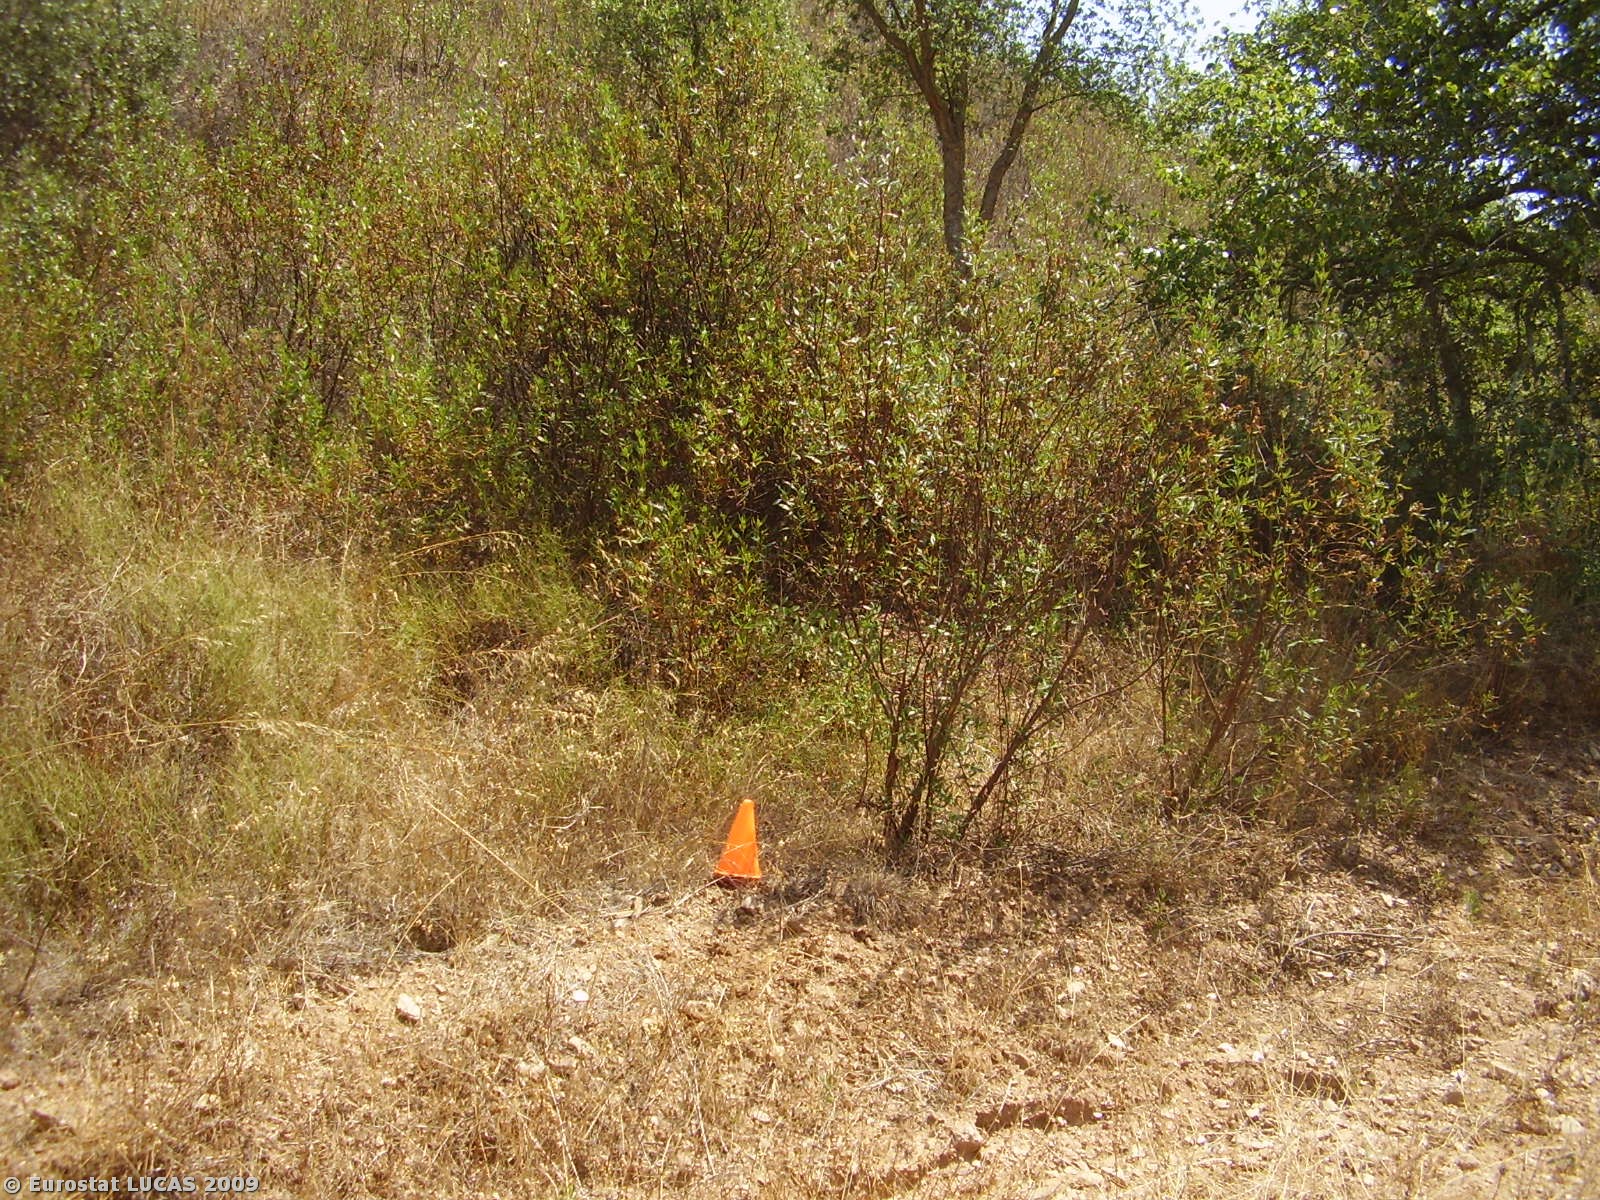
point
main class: Shrubland
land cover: Shrubland with sparse tree cover
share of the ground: > 75 %
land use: Fallow land
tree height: > 5 m
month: August
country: PT
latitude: 37.6305
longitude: -8.3543
